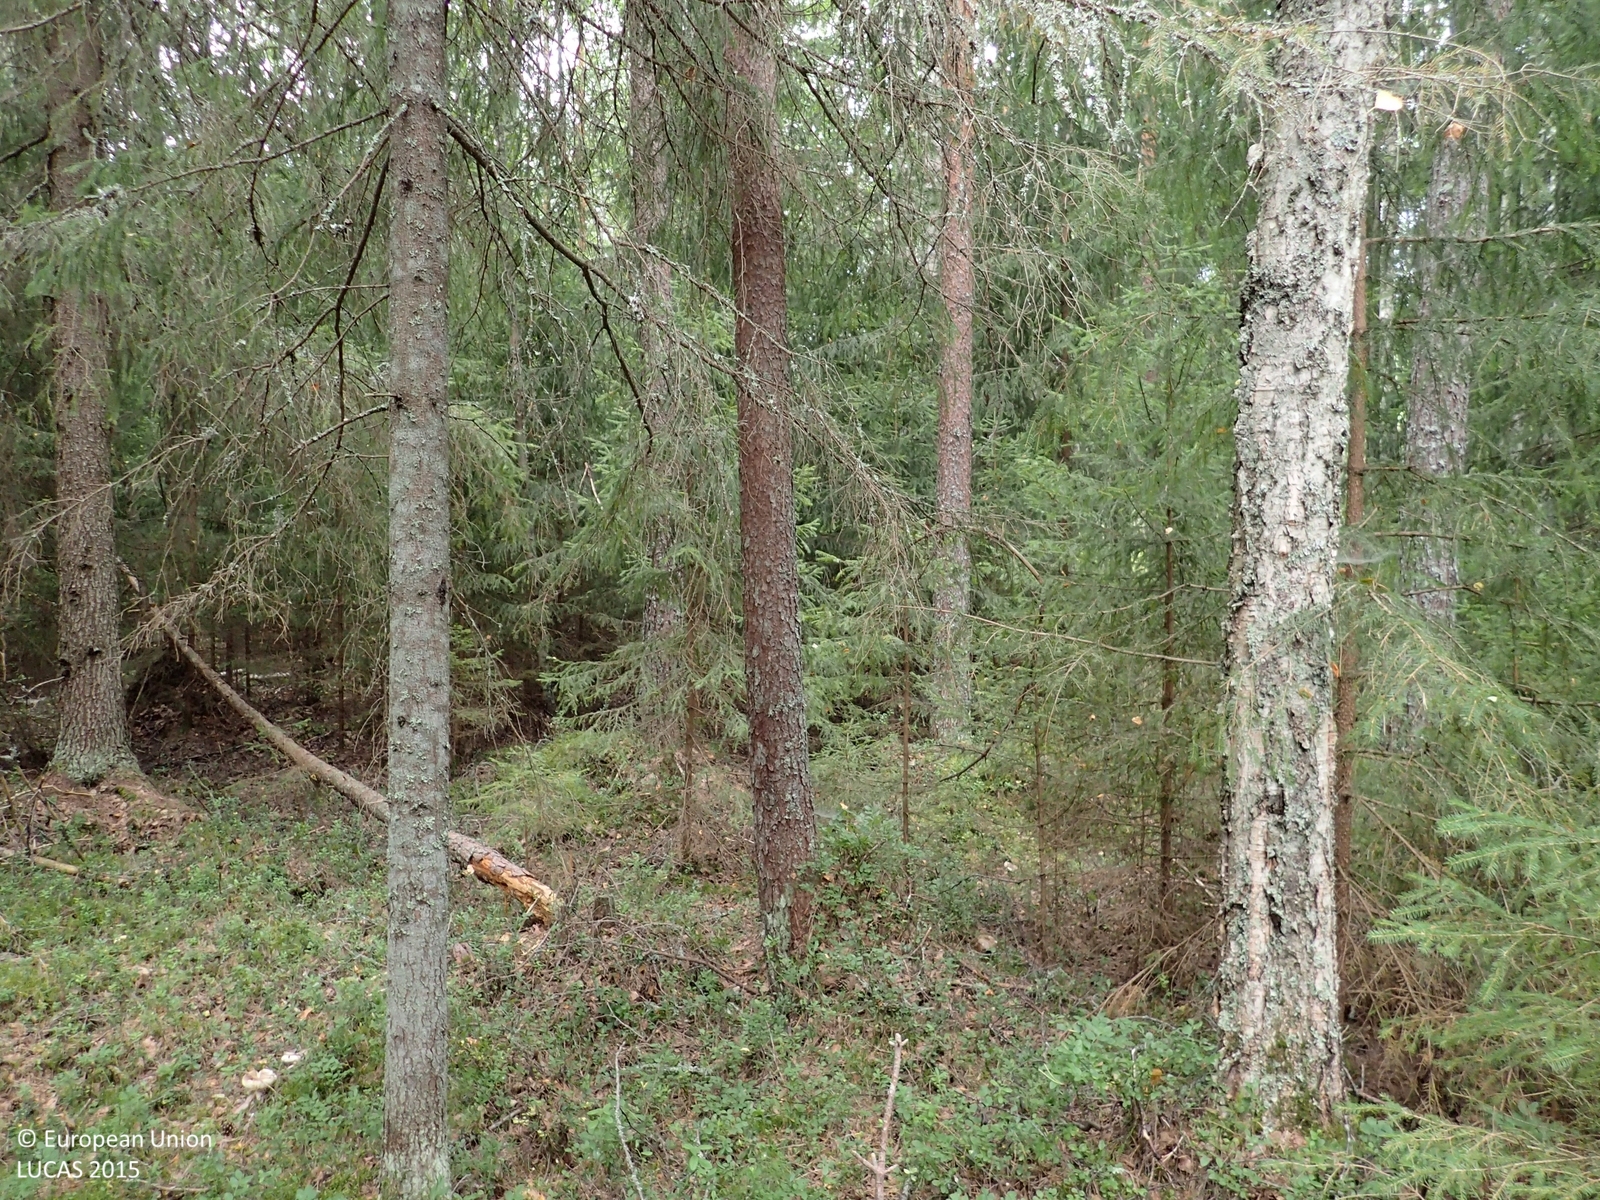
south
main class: Woodland
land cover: Other coniferous woodland
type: boreal forest
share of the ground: > 75 %
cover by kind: coniferous forest trees 70 %, shrubs 15 %, broadleaved forest trees 10 %, lichens and mosses 5 %
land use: Forestry
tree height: > 5 m
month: August
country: FI
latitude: 62.6656
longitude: 22.6078
